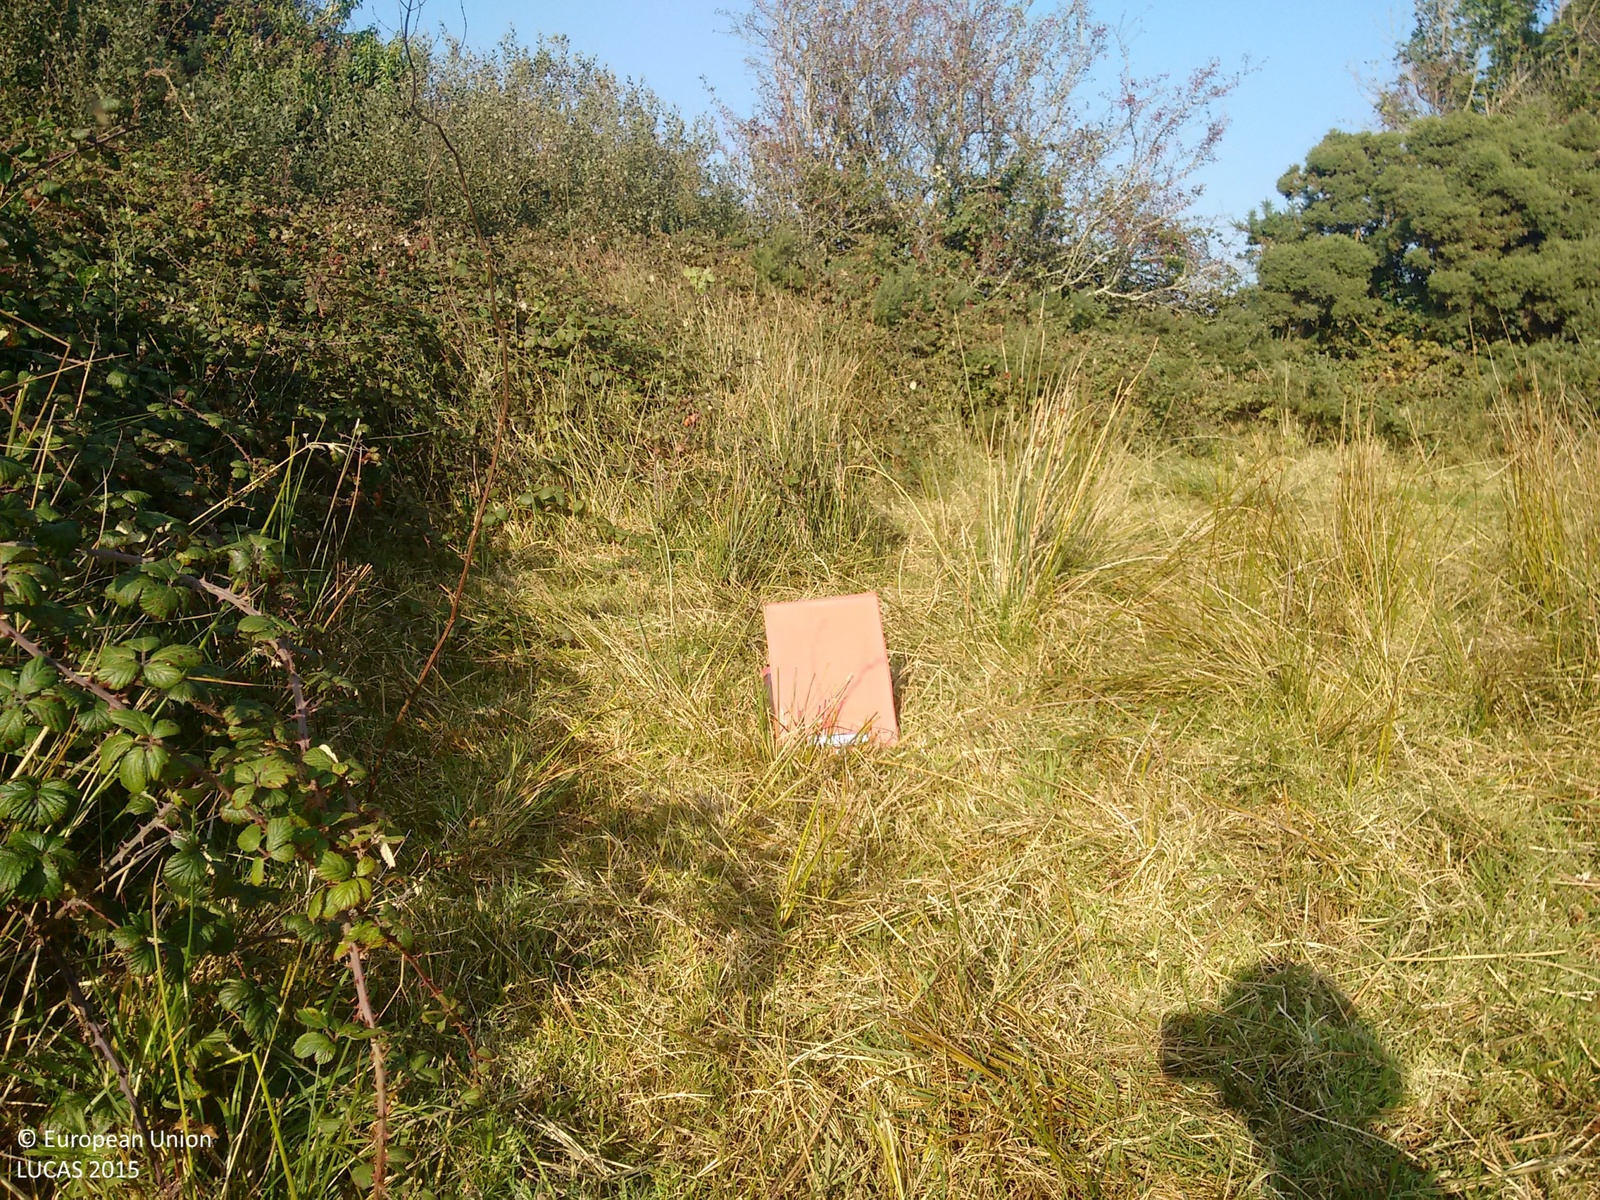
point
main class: Grassland
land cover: Grassland without tree/shrub cover
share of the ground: > 75 %
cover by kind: herbaceous plants 75 %, shrubs 5 %
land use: Agriculture (excluding fallow land and kitchen gardens)
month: October
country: IE
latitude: 52.4700
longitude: -9.1038
